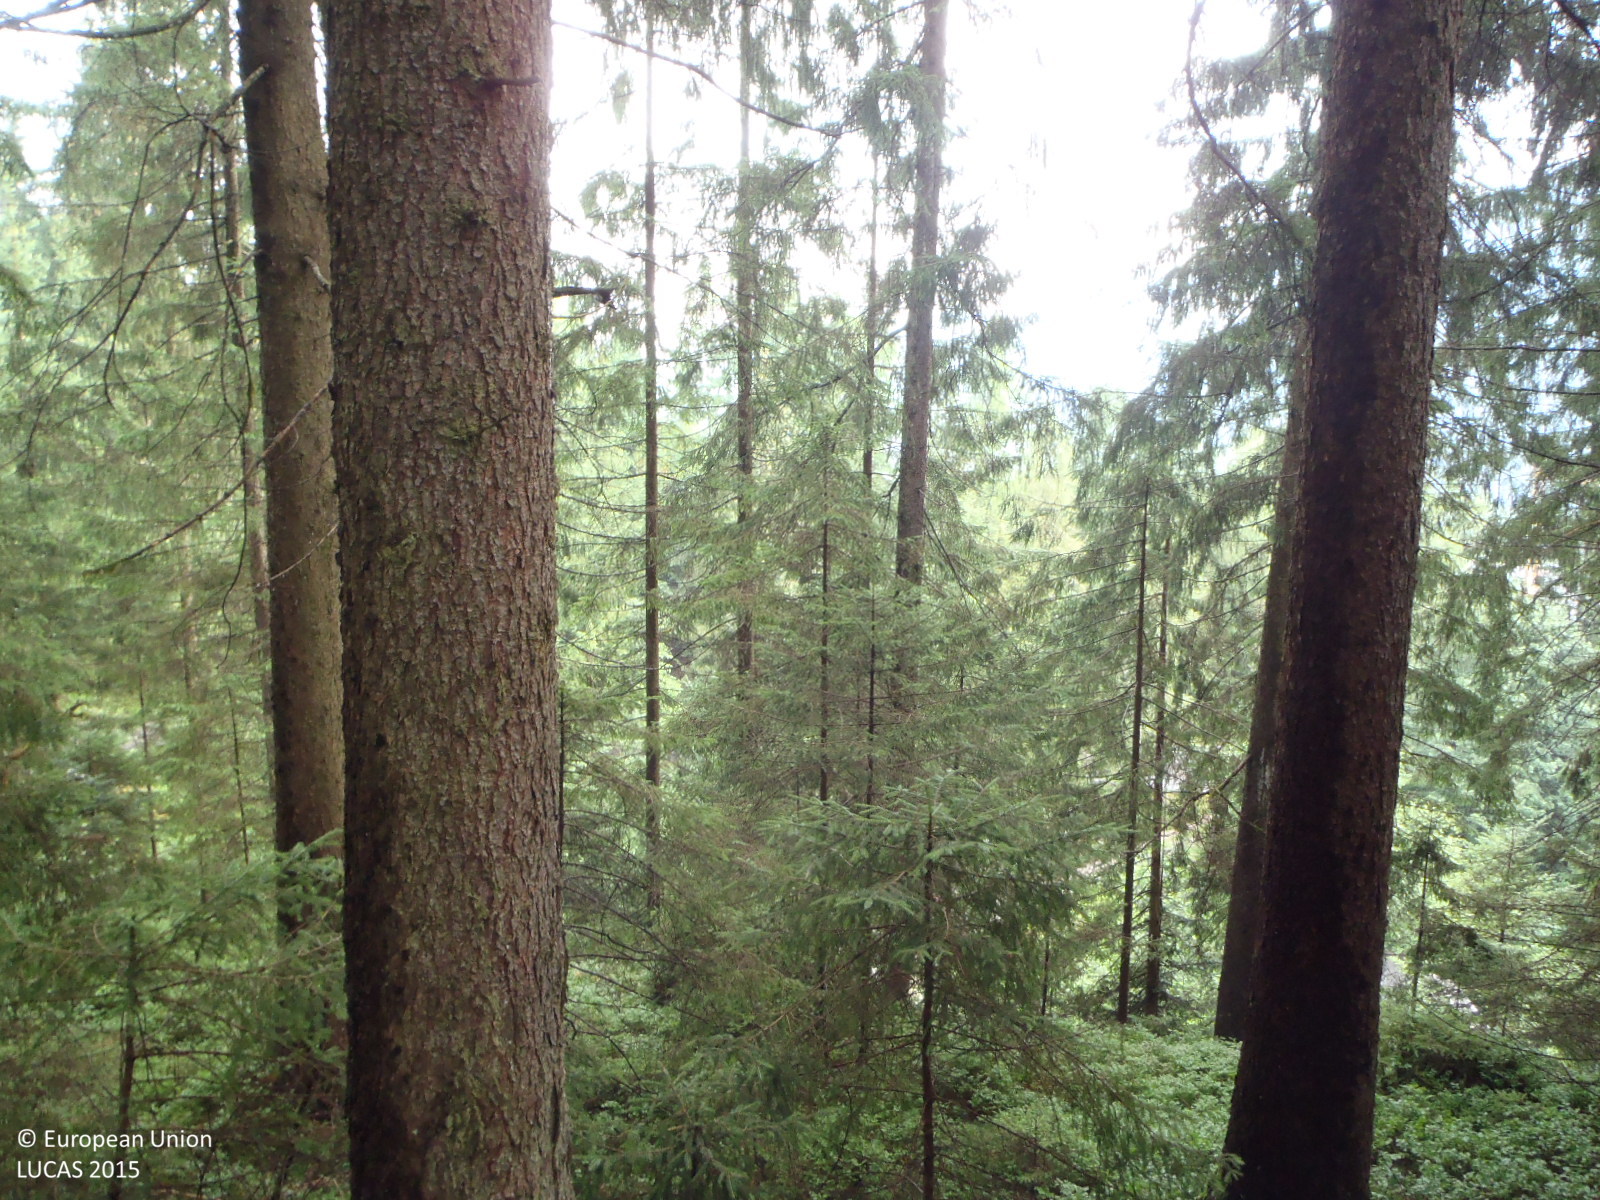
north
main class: Woodland
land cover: Spruce dominated coniferous woodland
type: alpine coniferous forest
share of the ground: > 75 %
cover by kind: coniferous forest trees 85 %, broadleaved forest trees 15 %
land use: Forestry
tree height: > 5 m
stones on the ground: < 10 %
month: July
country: AT
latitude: 47.2896
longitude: 11.8628
